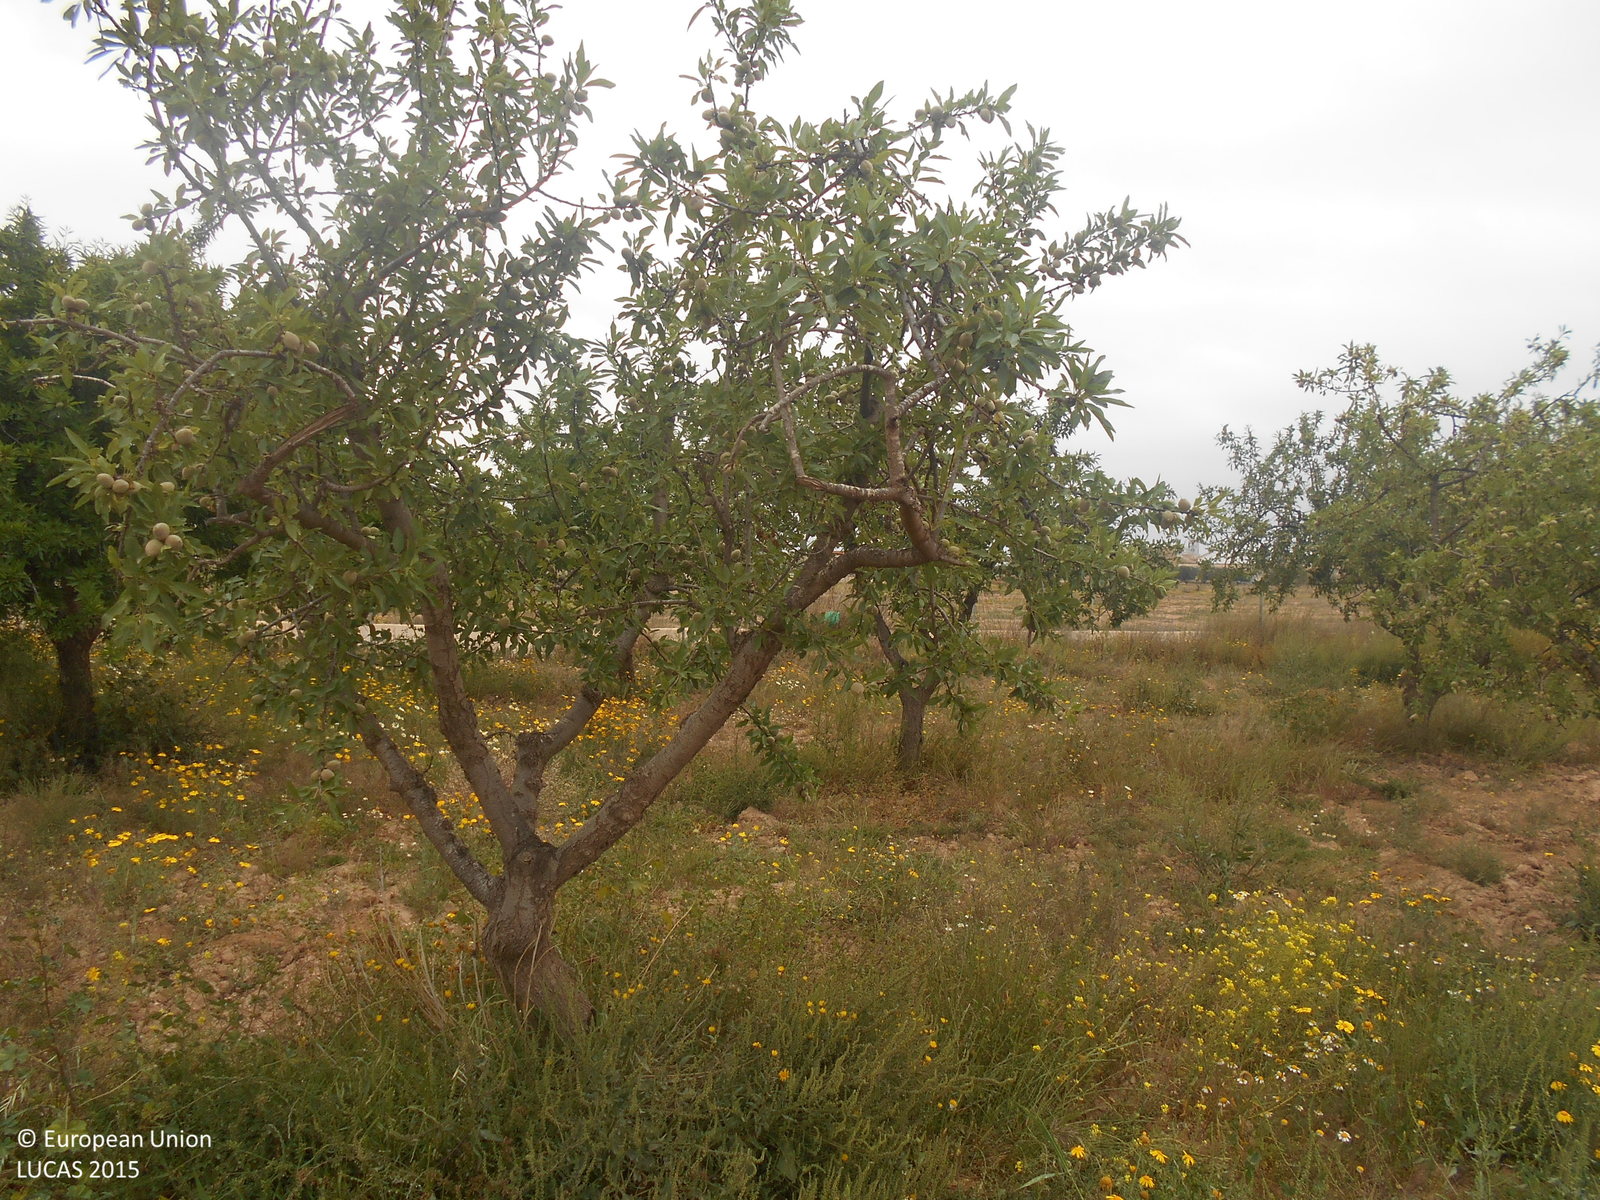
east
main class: Cropland
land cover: Nuts trees
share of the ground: 10 - 25 %
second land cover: Spontaneously vegetated surfaces
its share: 25 - 50 %
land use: Agriculture (excluding fallow land and kitchen gardens)
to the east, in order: Nuts trees; Spontaneously vegetated surfaces; Shruby margins; Fences; Artificial constructions in urban areas; Fences; Grassland without tree/shrub cover; Nuts trees; Dry stone walls; Artificial constructions in urban areas; Dry stone walls; Other bare soil; Fences; Grassland without tree/shrub cover; Fences; Grassland without tree/shrub cover
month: April
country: ES
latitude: 37.7364
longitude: -1.2492
